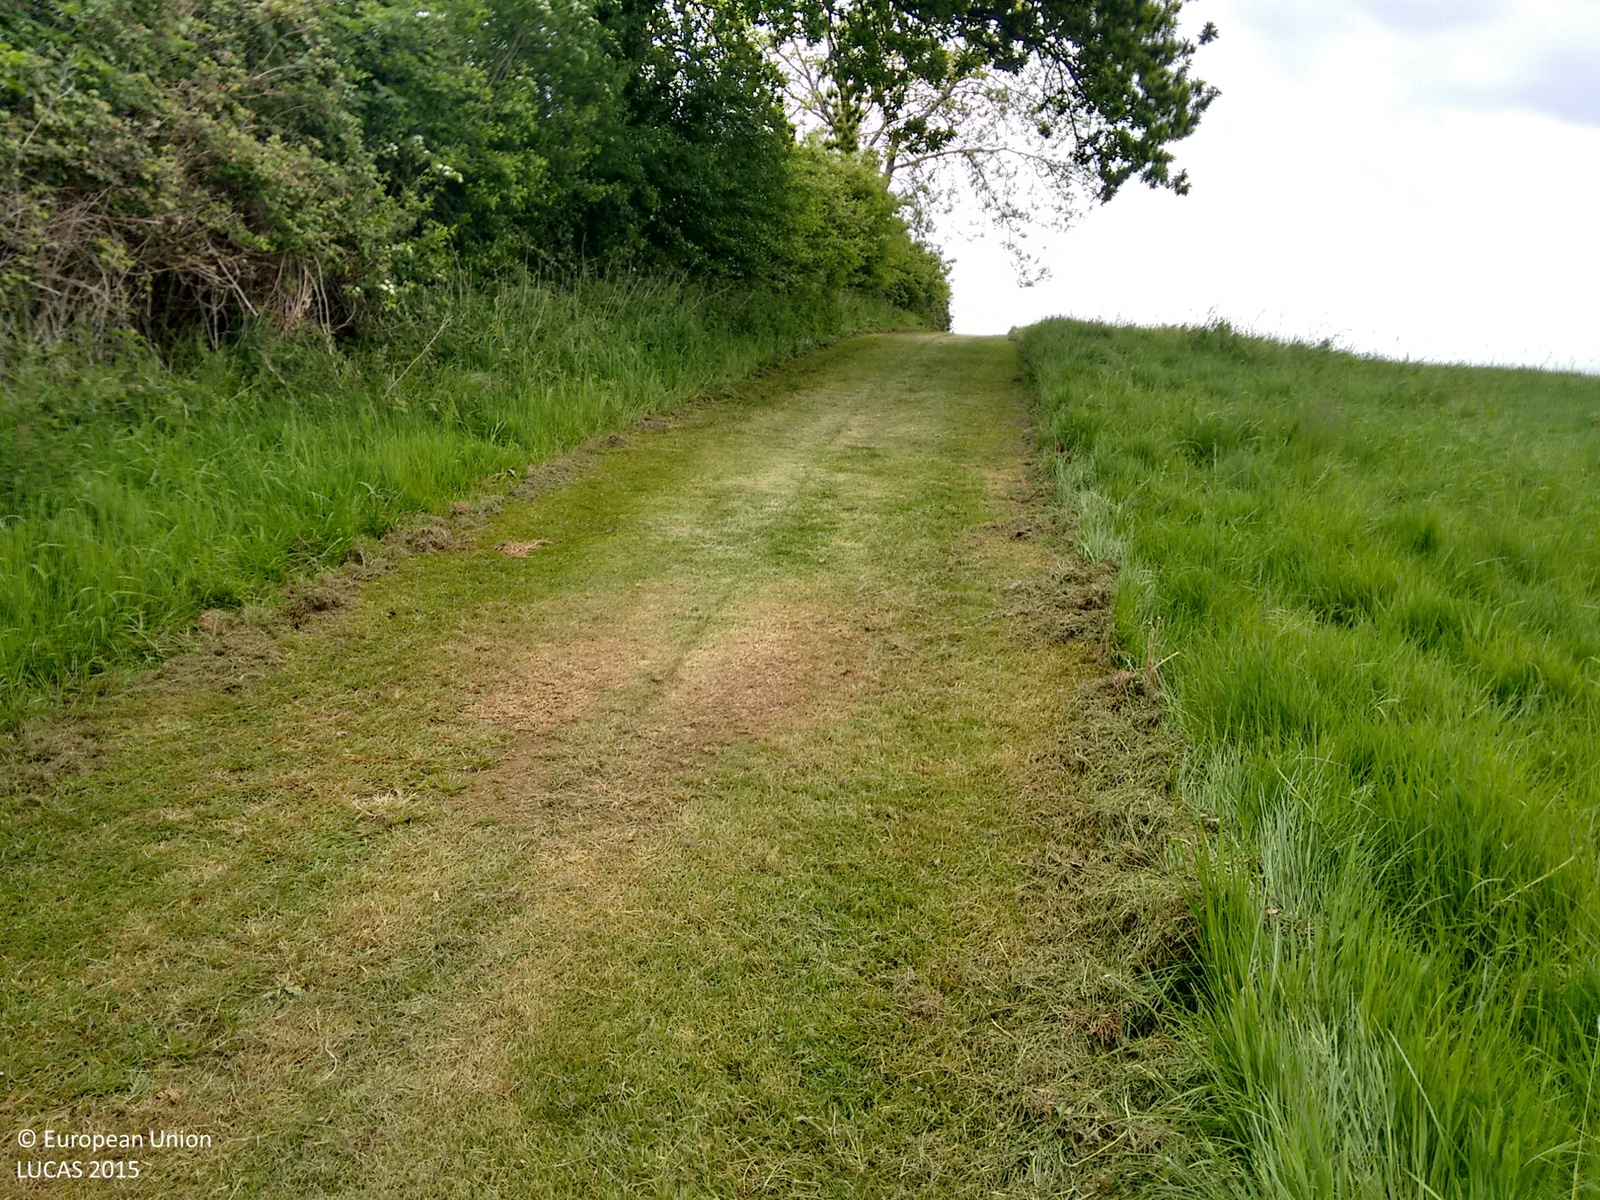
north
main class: Grassland
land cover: Grassland without tree/shrub cover
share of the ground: > 75 %
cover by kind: herbaceous plants 100 %
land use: Agriculture (excluding fallow land and kitchen gardens)
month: May
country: GB
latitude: 52.1171
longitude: -1.3970
